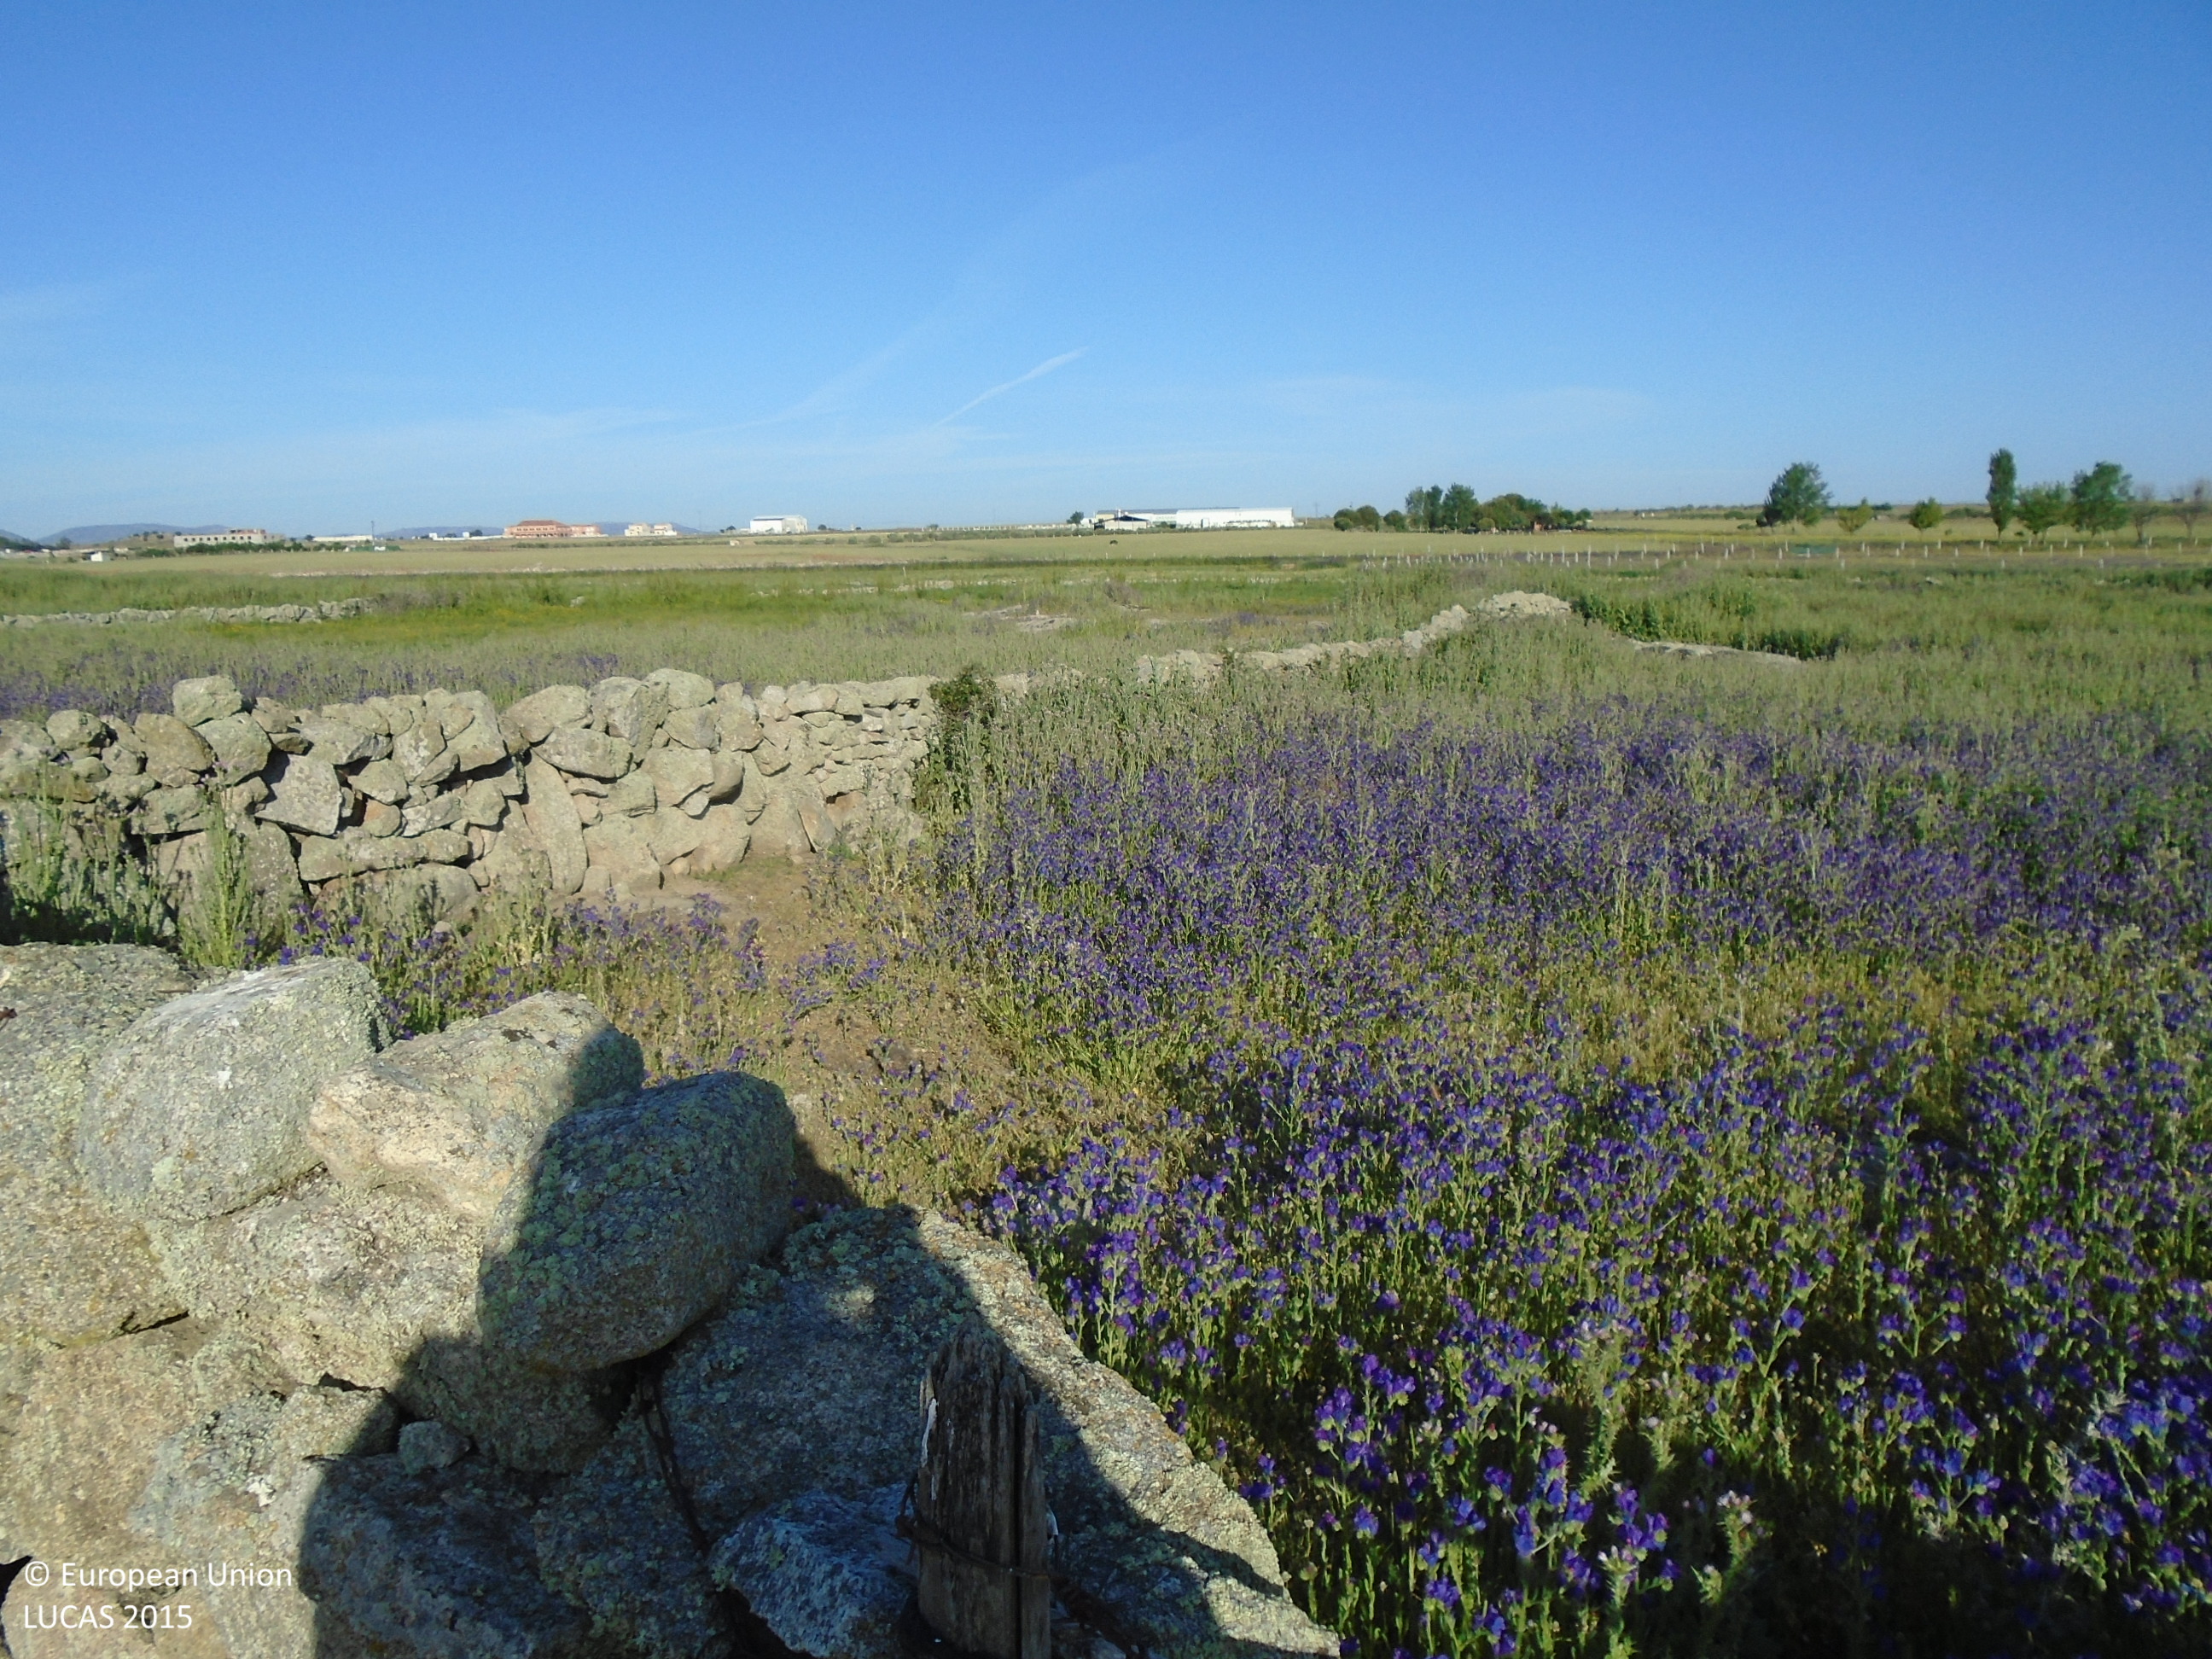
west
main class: Grassland
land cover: Spontaneously vegetated surfaces
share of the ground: > 75 %
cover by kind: herbaceous plants 100 %
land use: Agriculture (excluding fallow land and kitchen gardens)
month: May
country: ES
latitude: 39.6303
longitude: -4.2126
